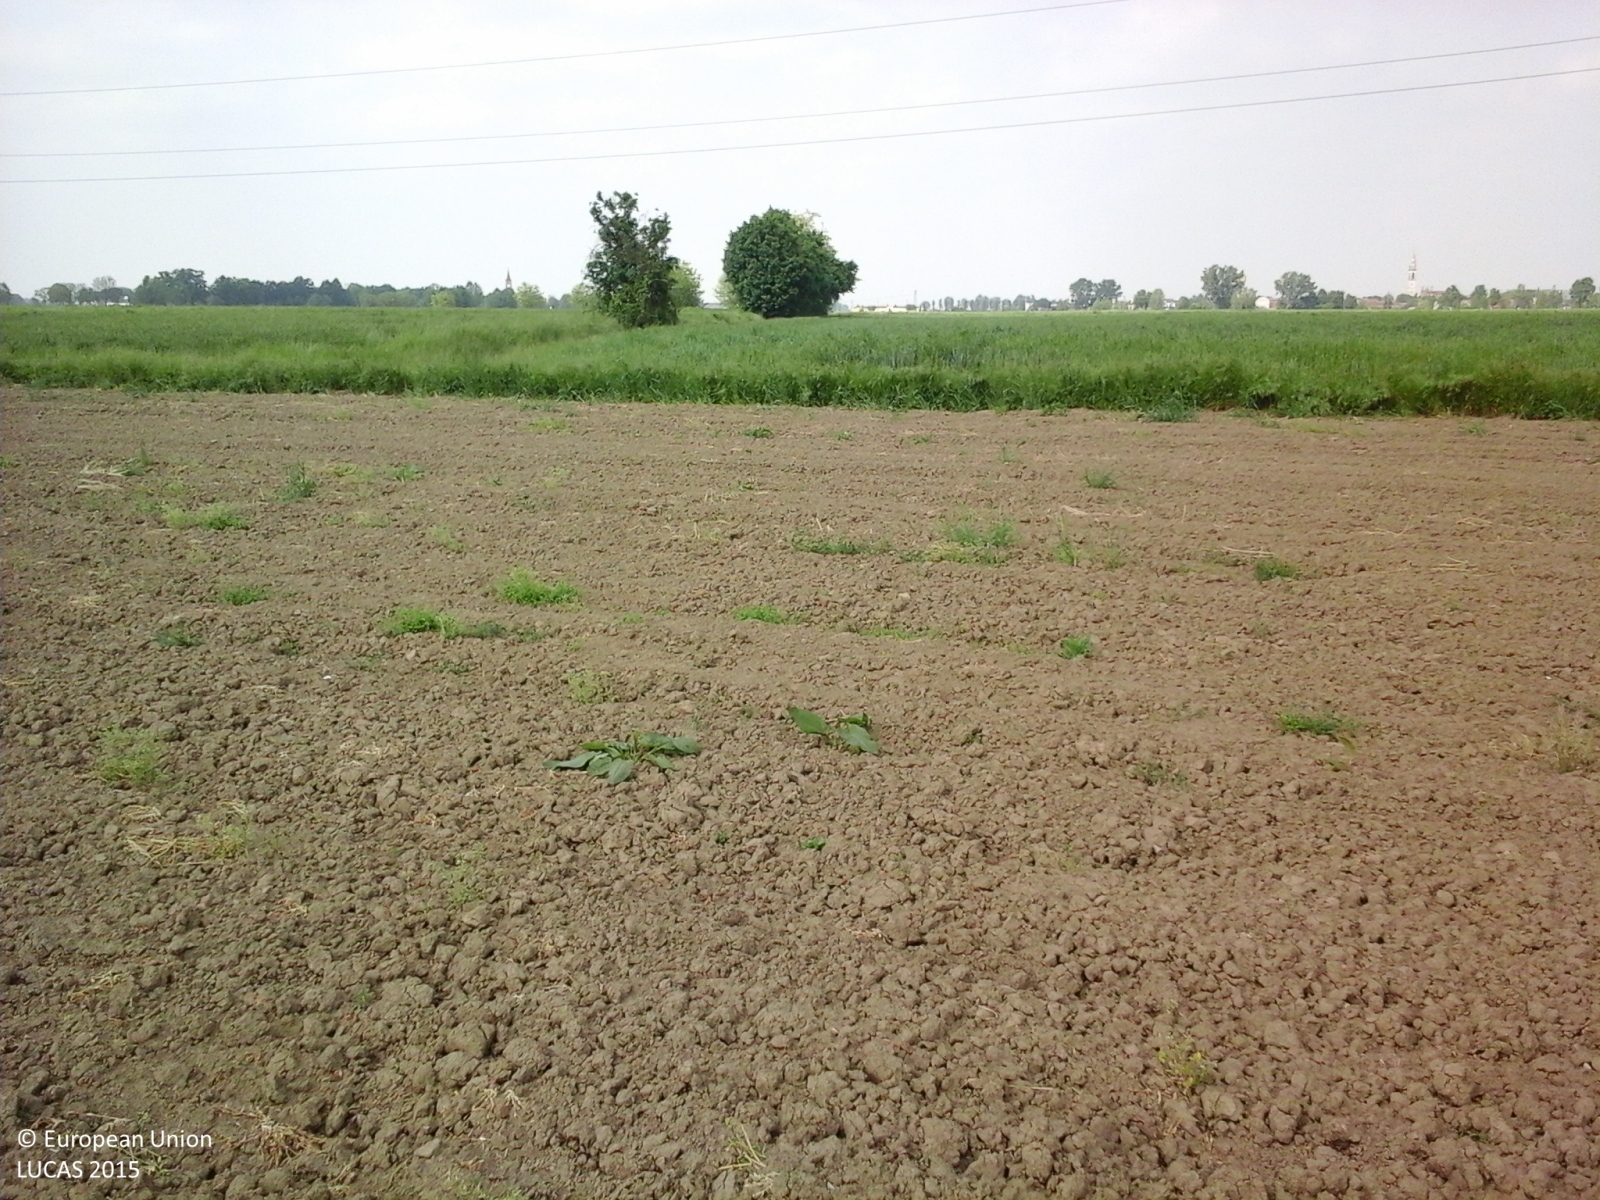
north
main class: Cropland
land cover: Maize
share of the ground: < 10 %
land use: Agriculture (excluding fallow land and kitchen gardens)
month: May
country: IT
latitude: 45.0715
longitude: 10.2662
